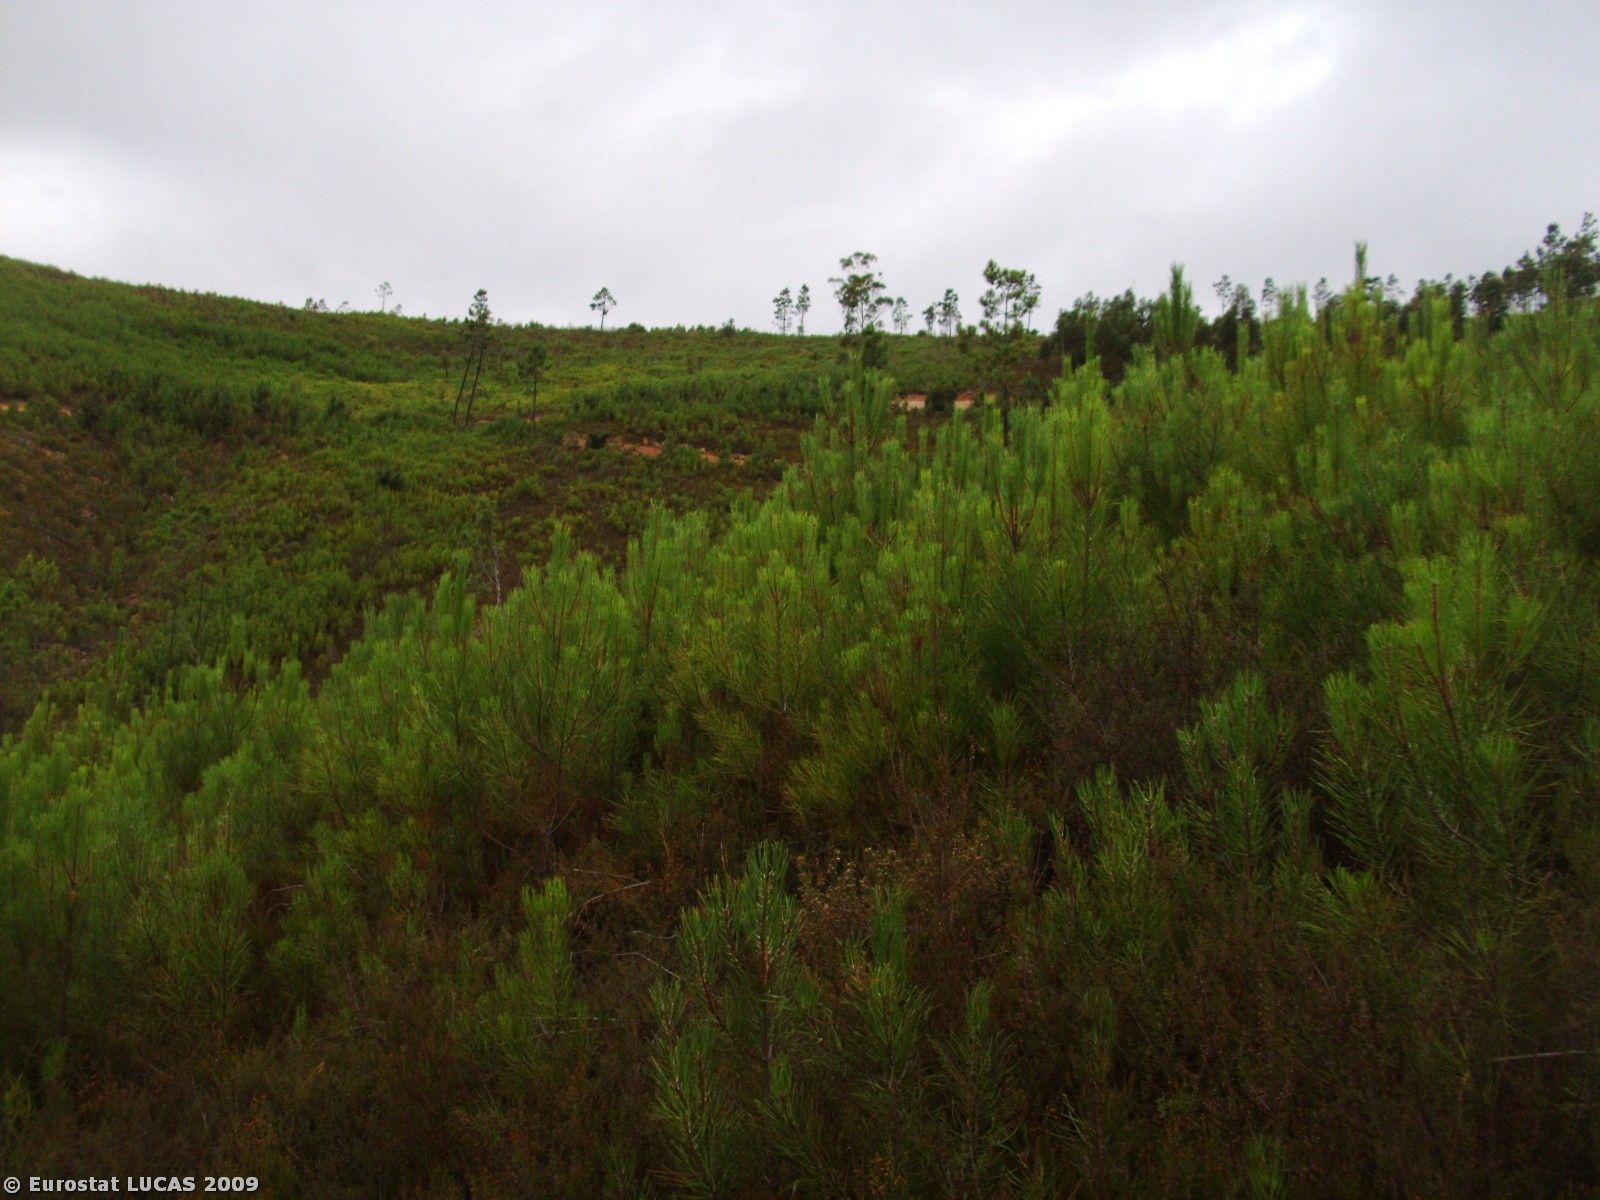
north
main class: Woodland
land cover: Coniferous woodland
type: coniferous forest of the mediterranean region
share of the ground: > 75 %
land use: Forestry
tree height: > 5 m
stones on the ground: > 50 %
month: July
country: PT
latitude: 39.6508
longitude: -8.1413
